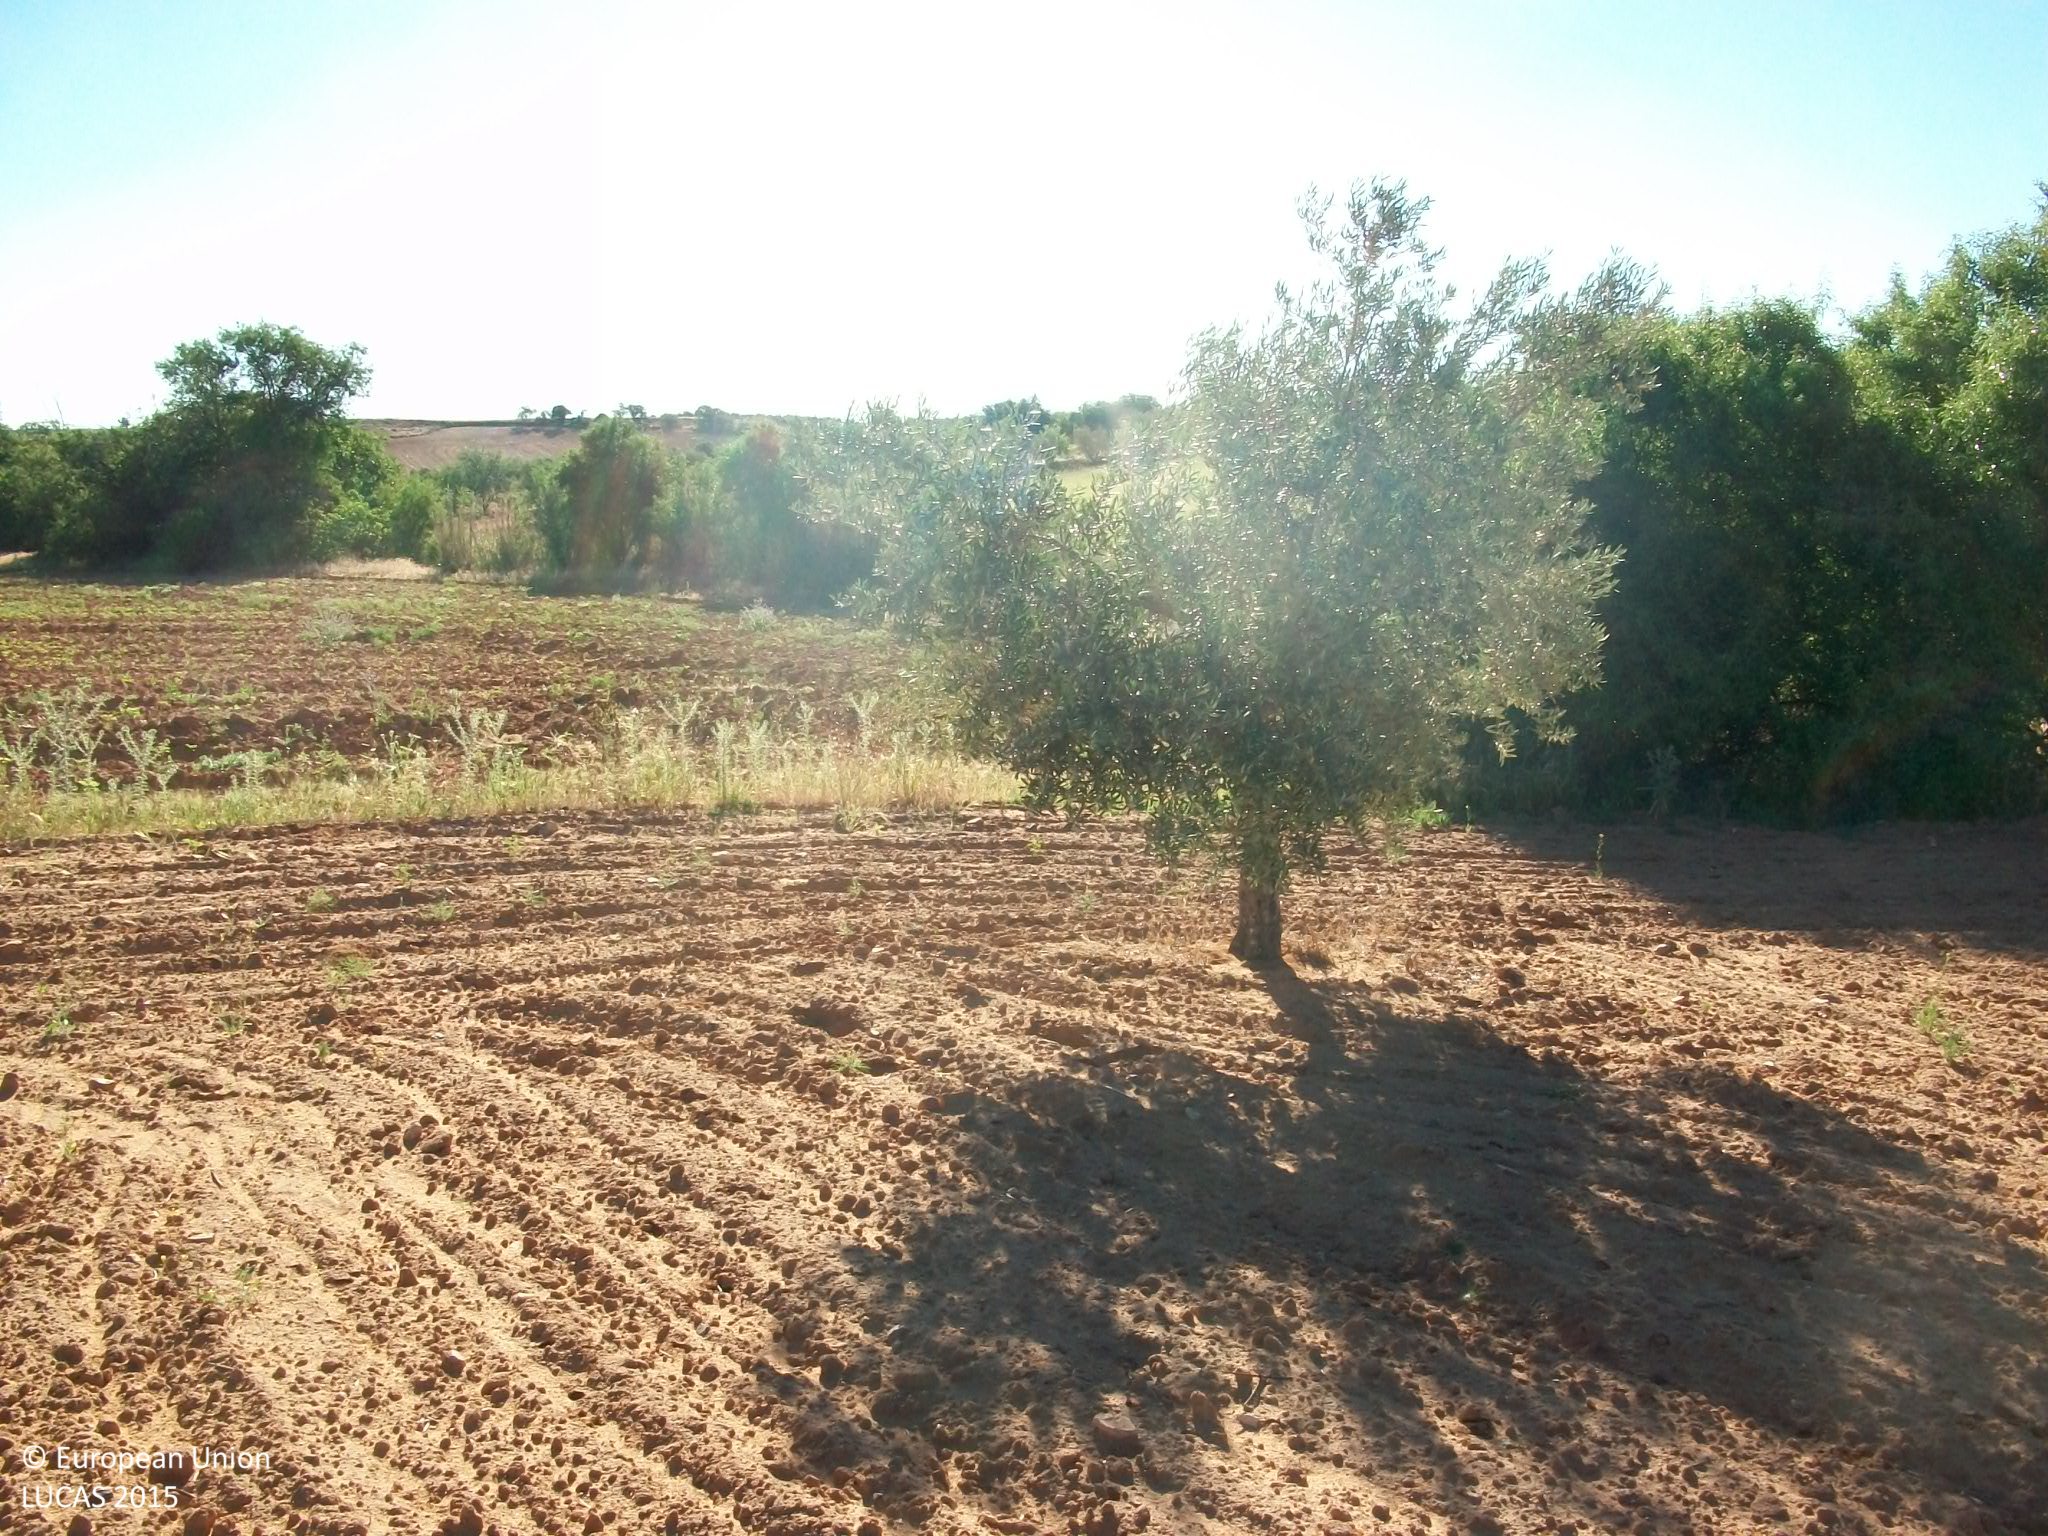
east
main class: Cropland
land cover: Olive groves
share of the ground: 25 - 50 %
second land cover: Other bare soil
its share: > 75 %
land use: Agriculture (excluding fallow land and kitchen gardens)
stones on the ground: < 10 %
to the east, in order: Olive groves; Other bare soil; Grass margins; Barley; Grass margins; Rivers and streams; Managed hedges; Olive groves; Grass margins; Abandoned hedges; Spontaneously vegetated surfaces; Grass margins; Abandoned hedges; Olive groves
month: May
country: ES
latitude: 39.8341
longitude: -3.6894
